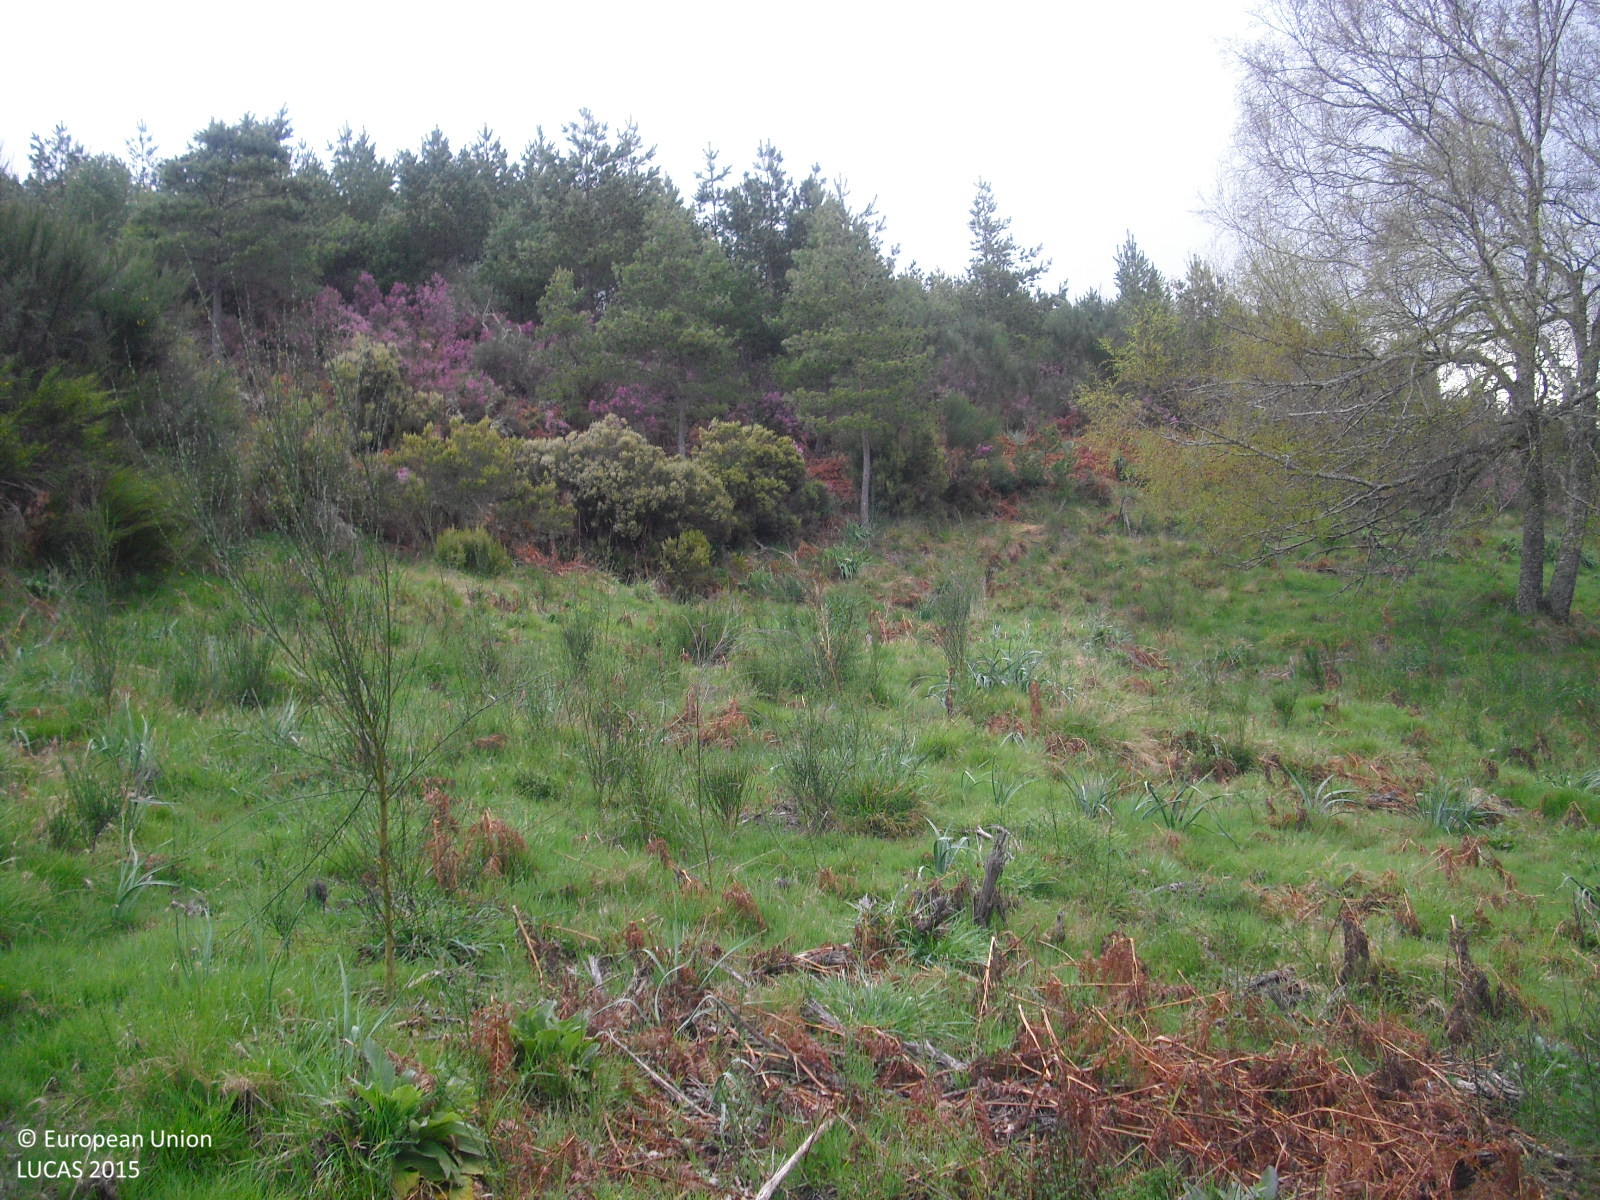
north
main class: Woodland
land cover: Broadleaved woodland
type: beech forest
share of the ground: 25 - 50 %
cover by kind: herbaceous plants 50 %, broadleaved forest trees 30 %, shrubs 20 %
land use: Forestry
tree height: > 5 m
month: April
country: ES
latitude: 41.9139
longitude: -7.6807
